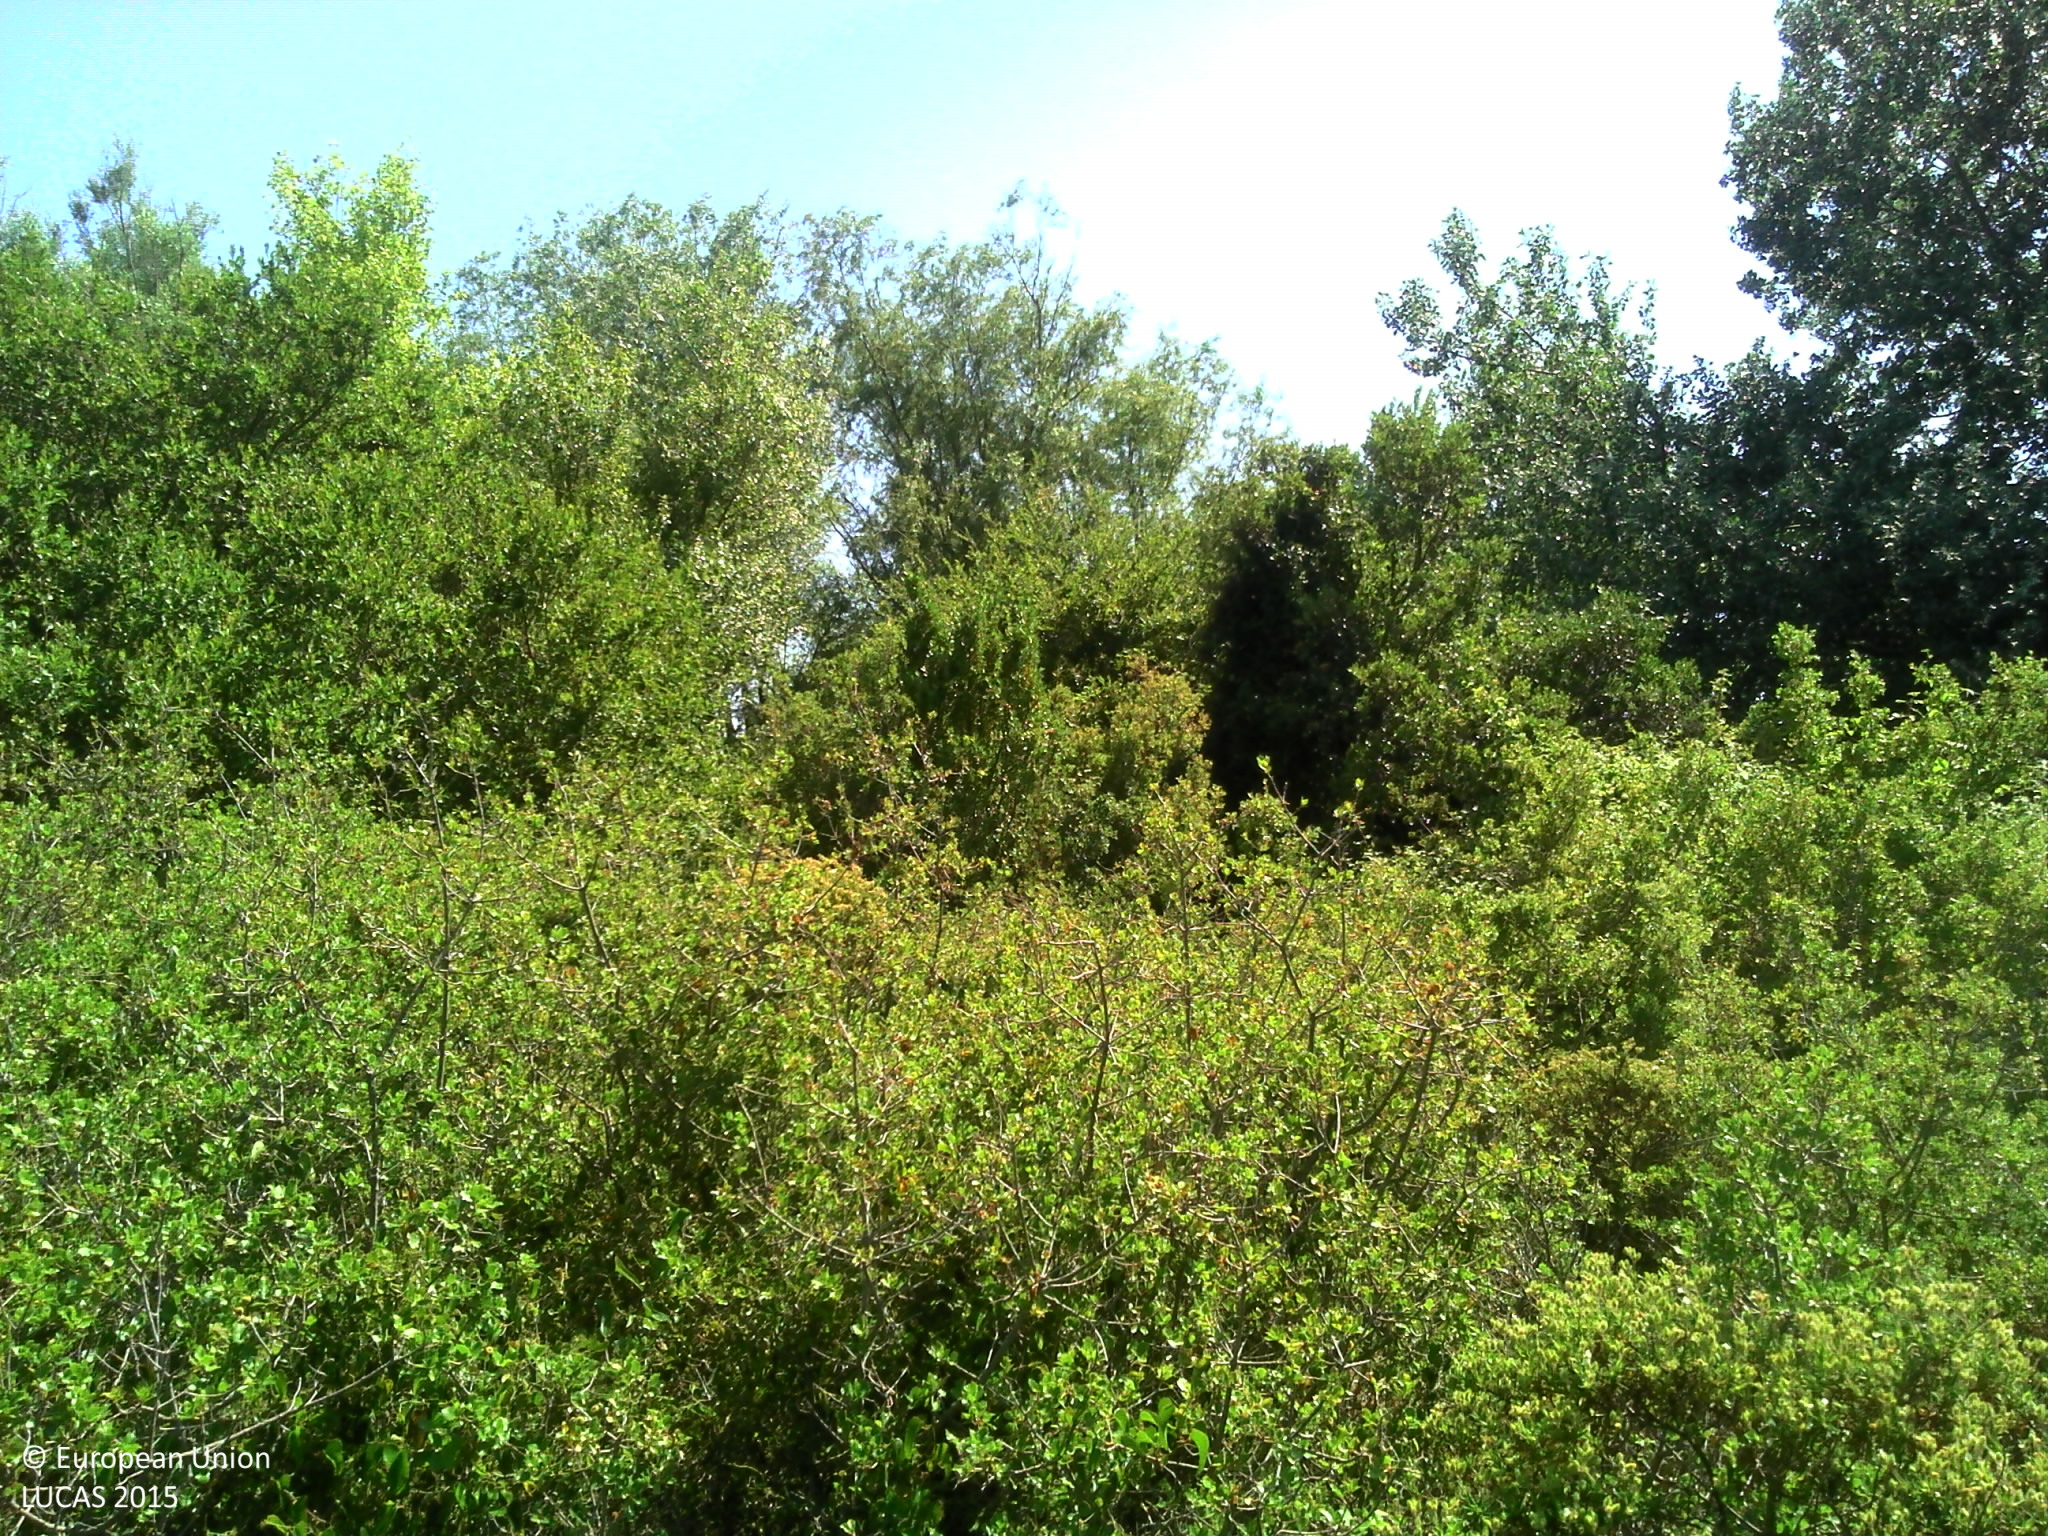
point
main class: Woodland
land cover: Broadleaved woodland
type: mesophytic deciduous forest
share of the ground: > 75 %
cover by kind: broadleaved forest trees 100 %
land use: Forestry
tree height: > 5 m
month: June
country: FR
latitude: 43.2208
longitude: 3.1773
